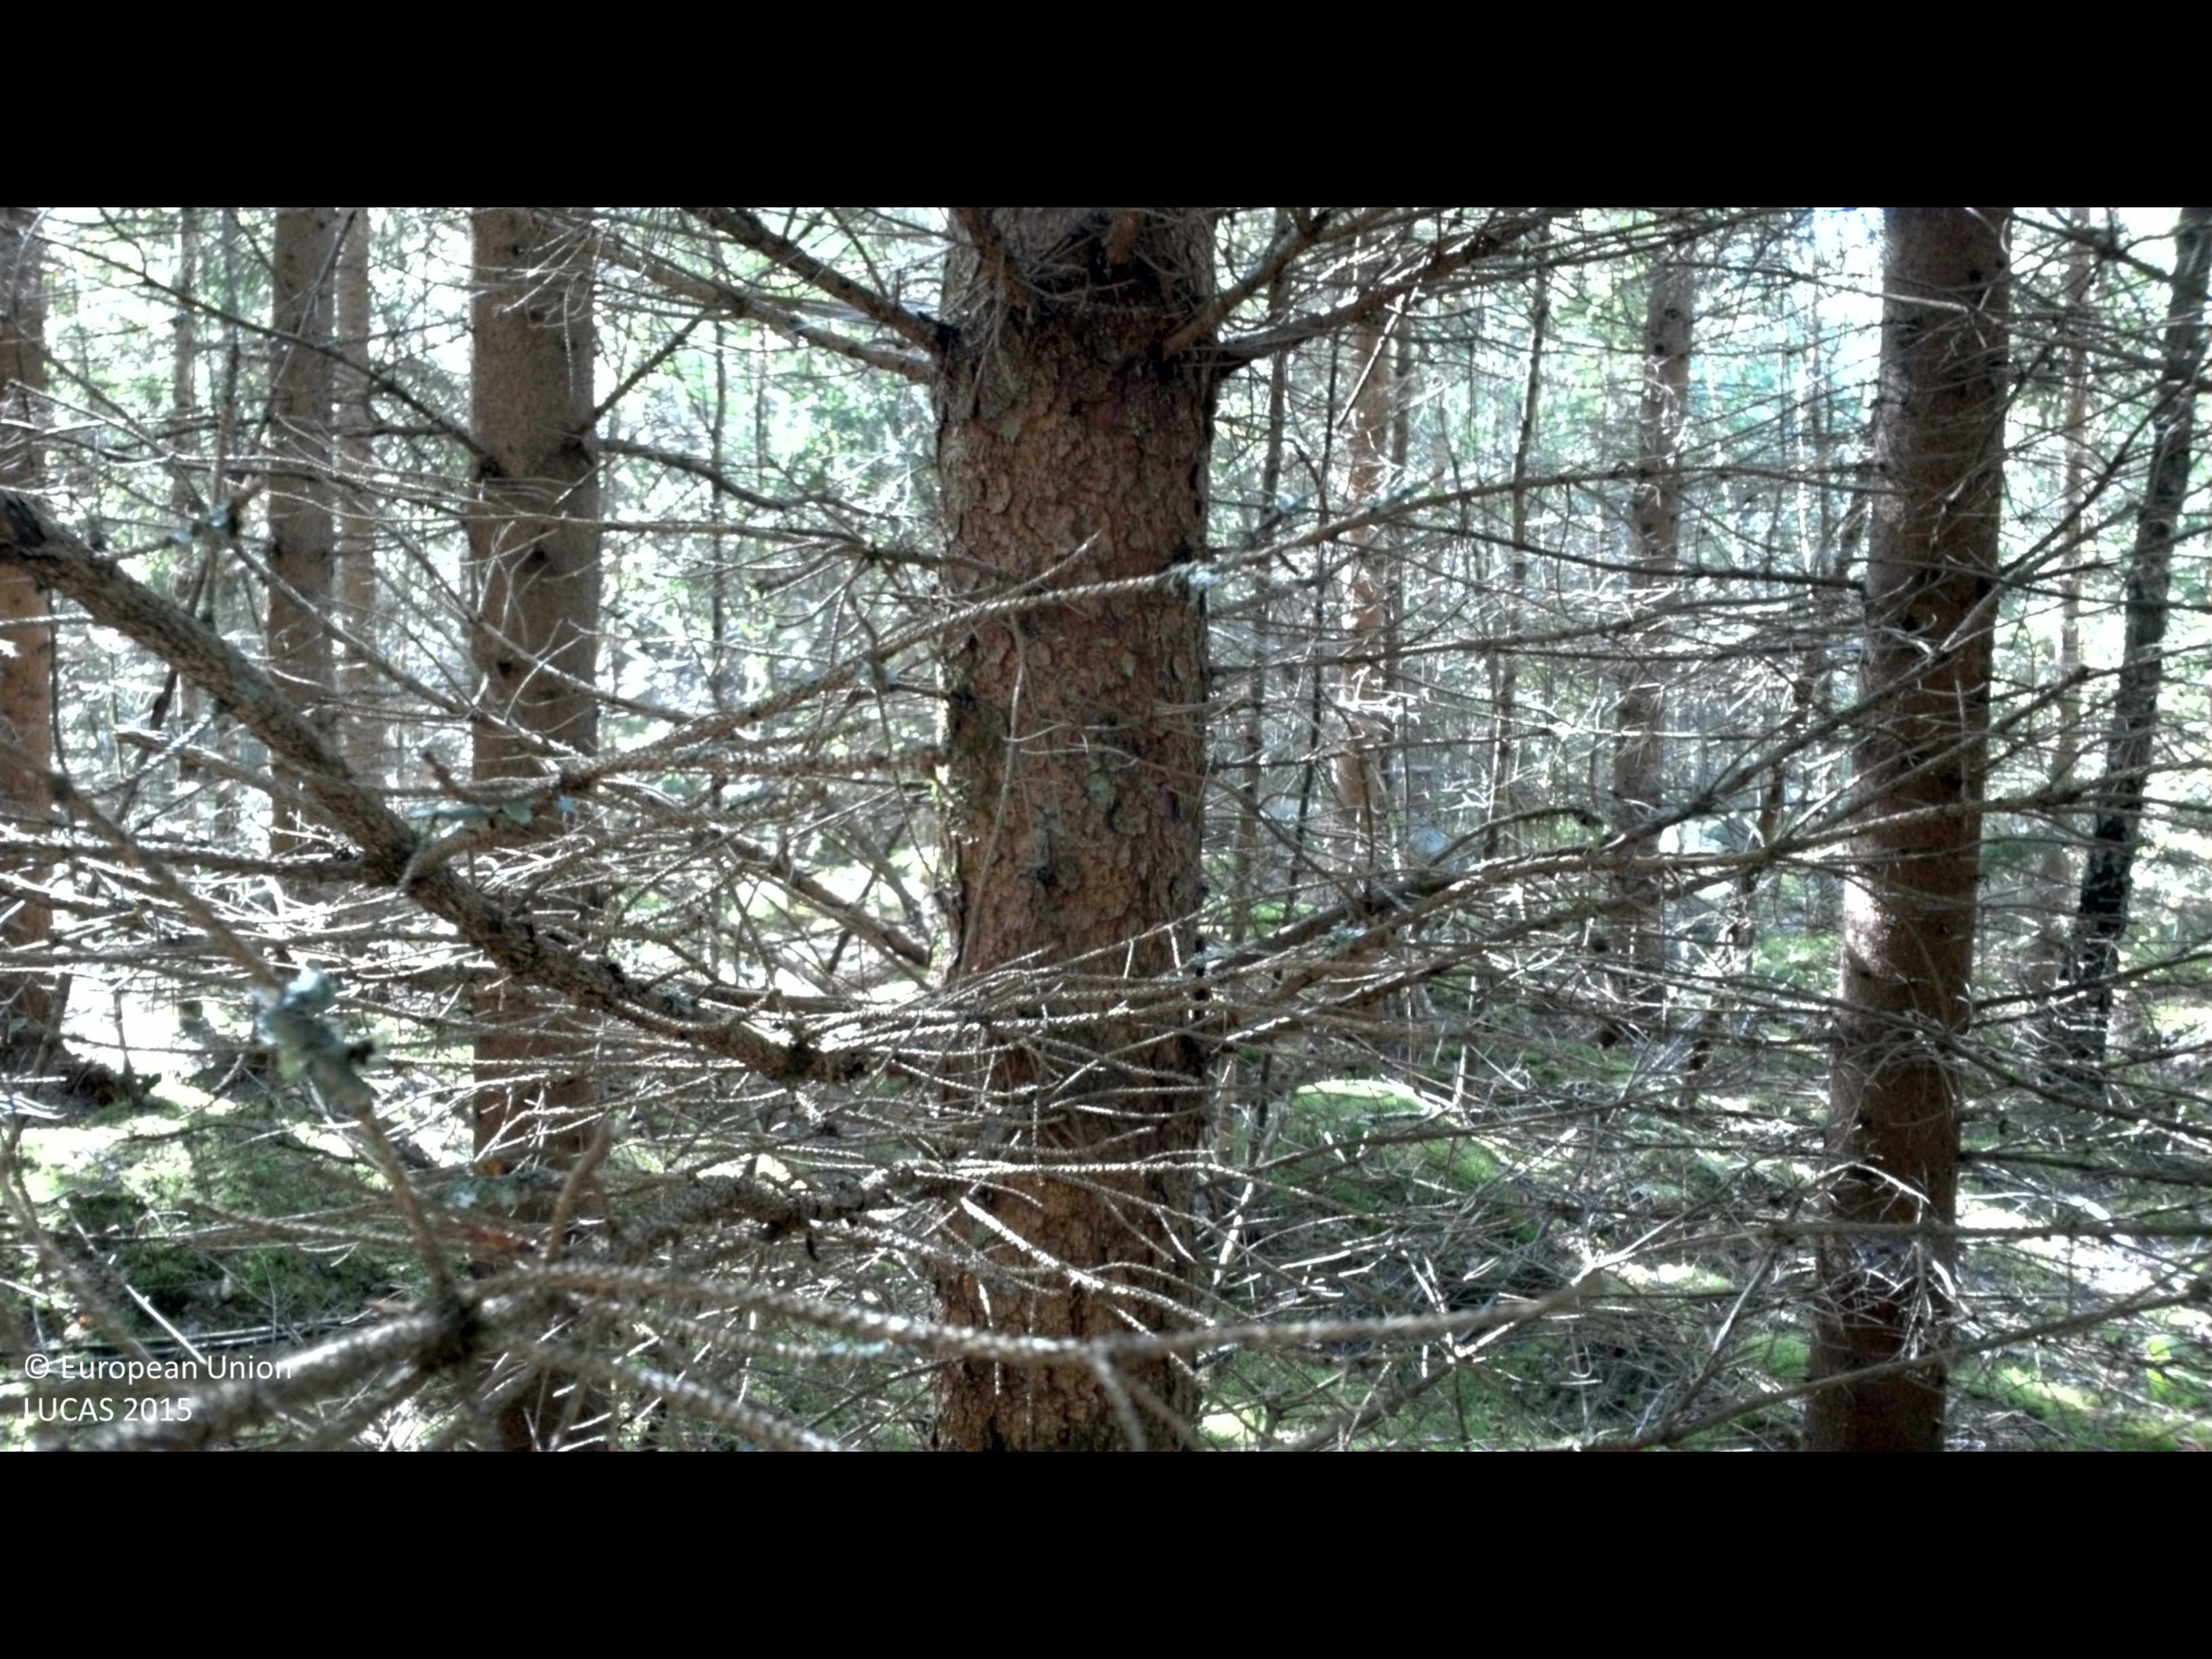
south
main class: Woodland
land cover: Spruce dominated coniferous woodland
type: boreal forest
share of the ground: > 75 %
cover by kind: coniferous forest trees 90 %, lichens and mosses 5 %, unconsolidated bare surface 5 %
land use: Forestry
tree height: > 5 m
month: August
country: SE
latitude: 56.3345
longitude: 14.7373
